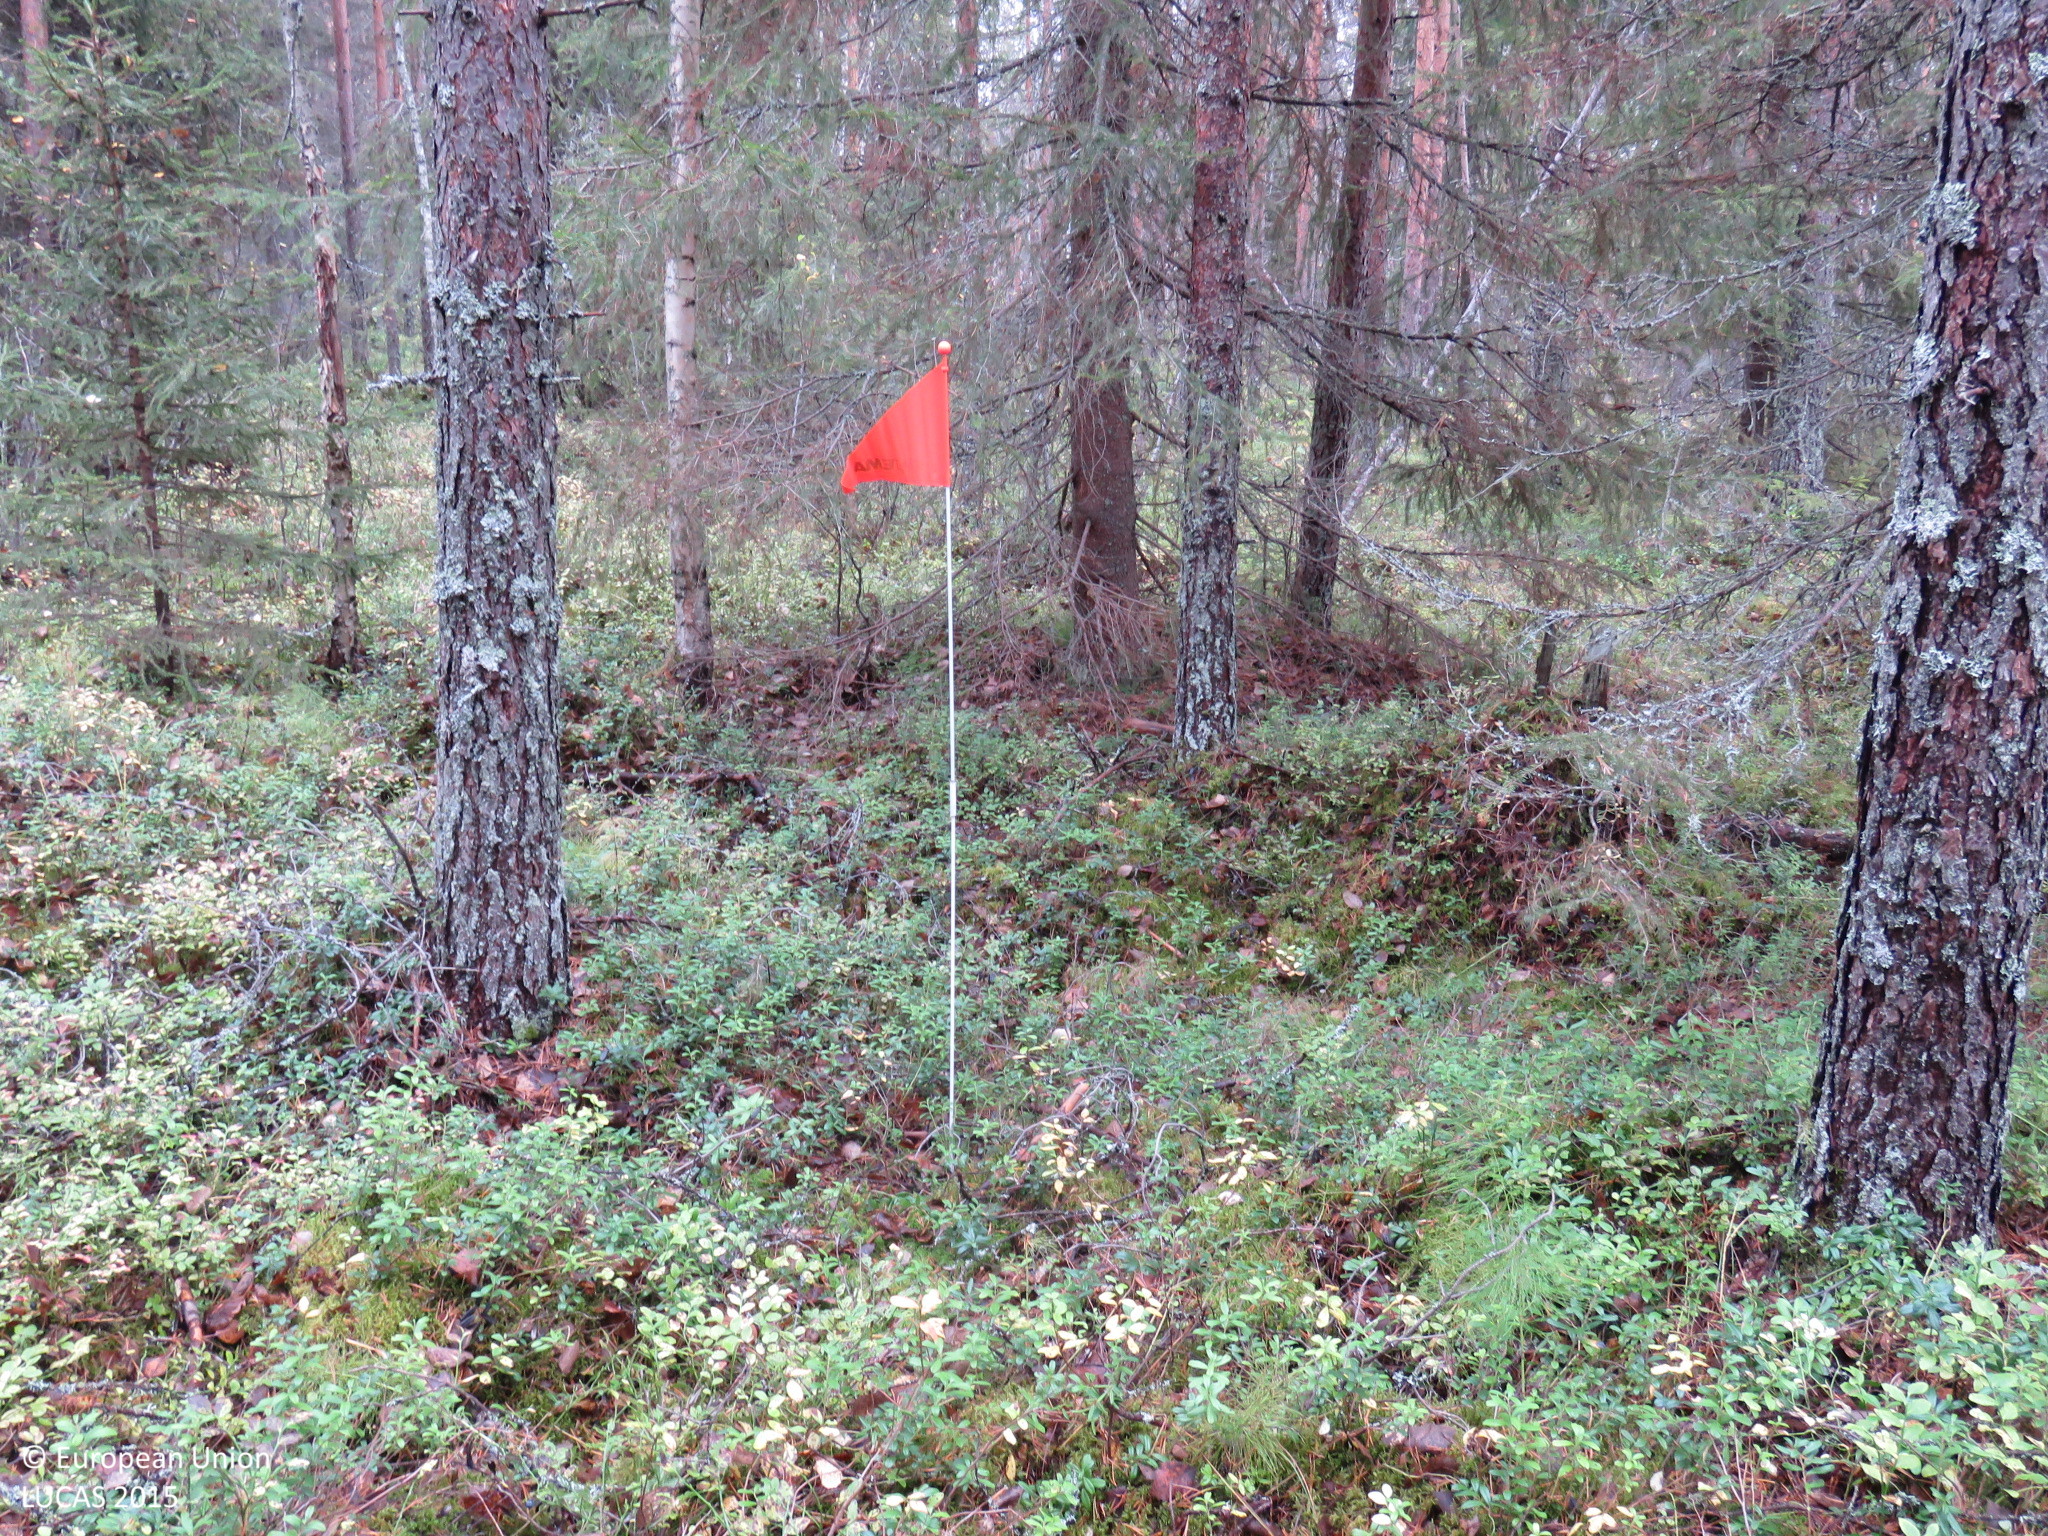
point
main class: Woodland
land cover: Other coniferous woodland
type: boreal forest
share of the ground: > 75 %
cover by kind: coniferous forest trees 70 %, shrubs 15 %, broadleaved forest trees 10 %, lichens and mosses 5 %
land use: Forestry
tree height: > 5 m
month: September
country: FI
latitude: 64.9528
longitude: 27.0377
